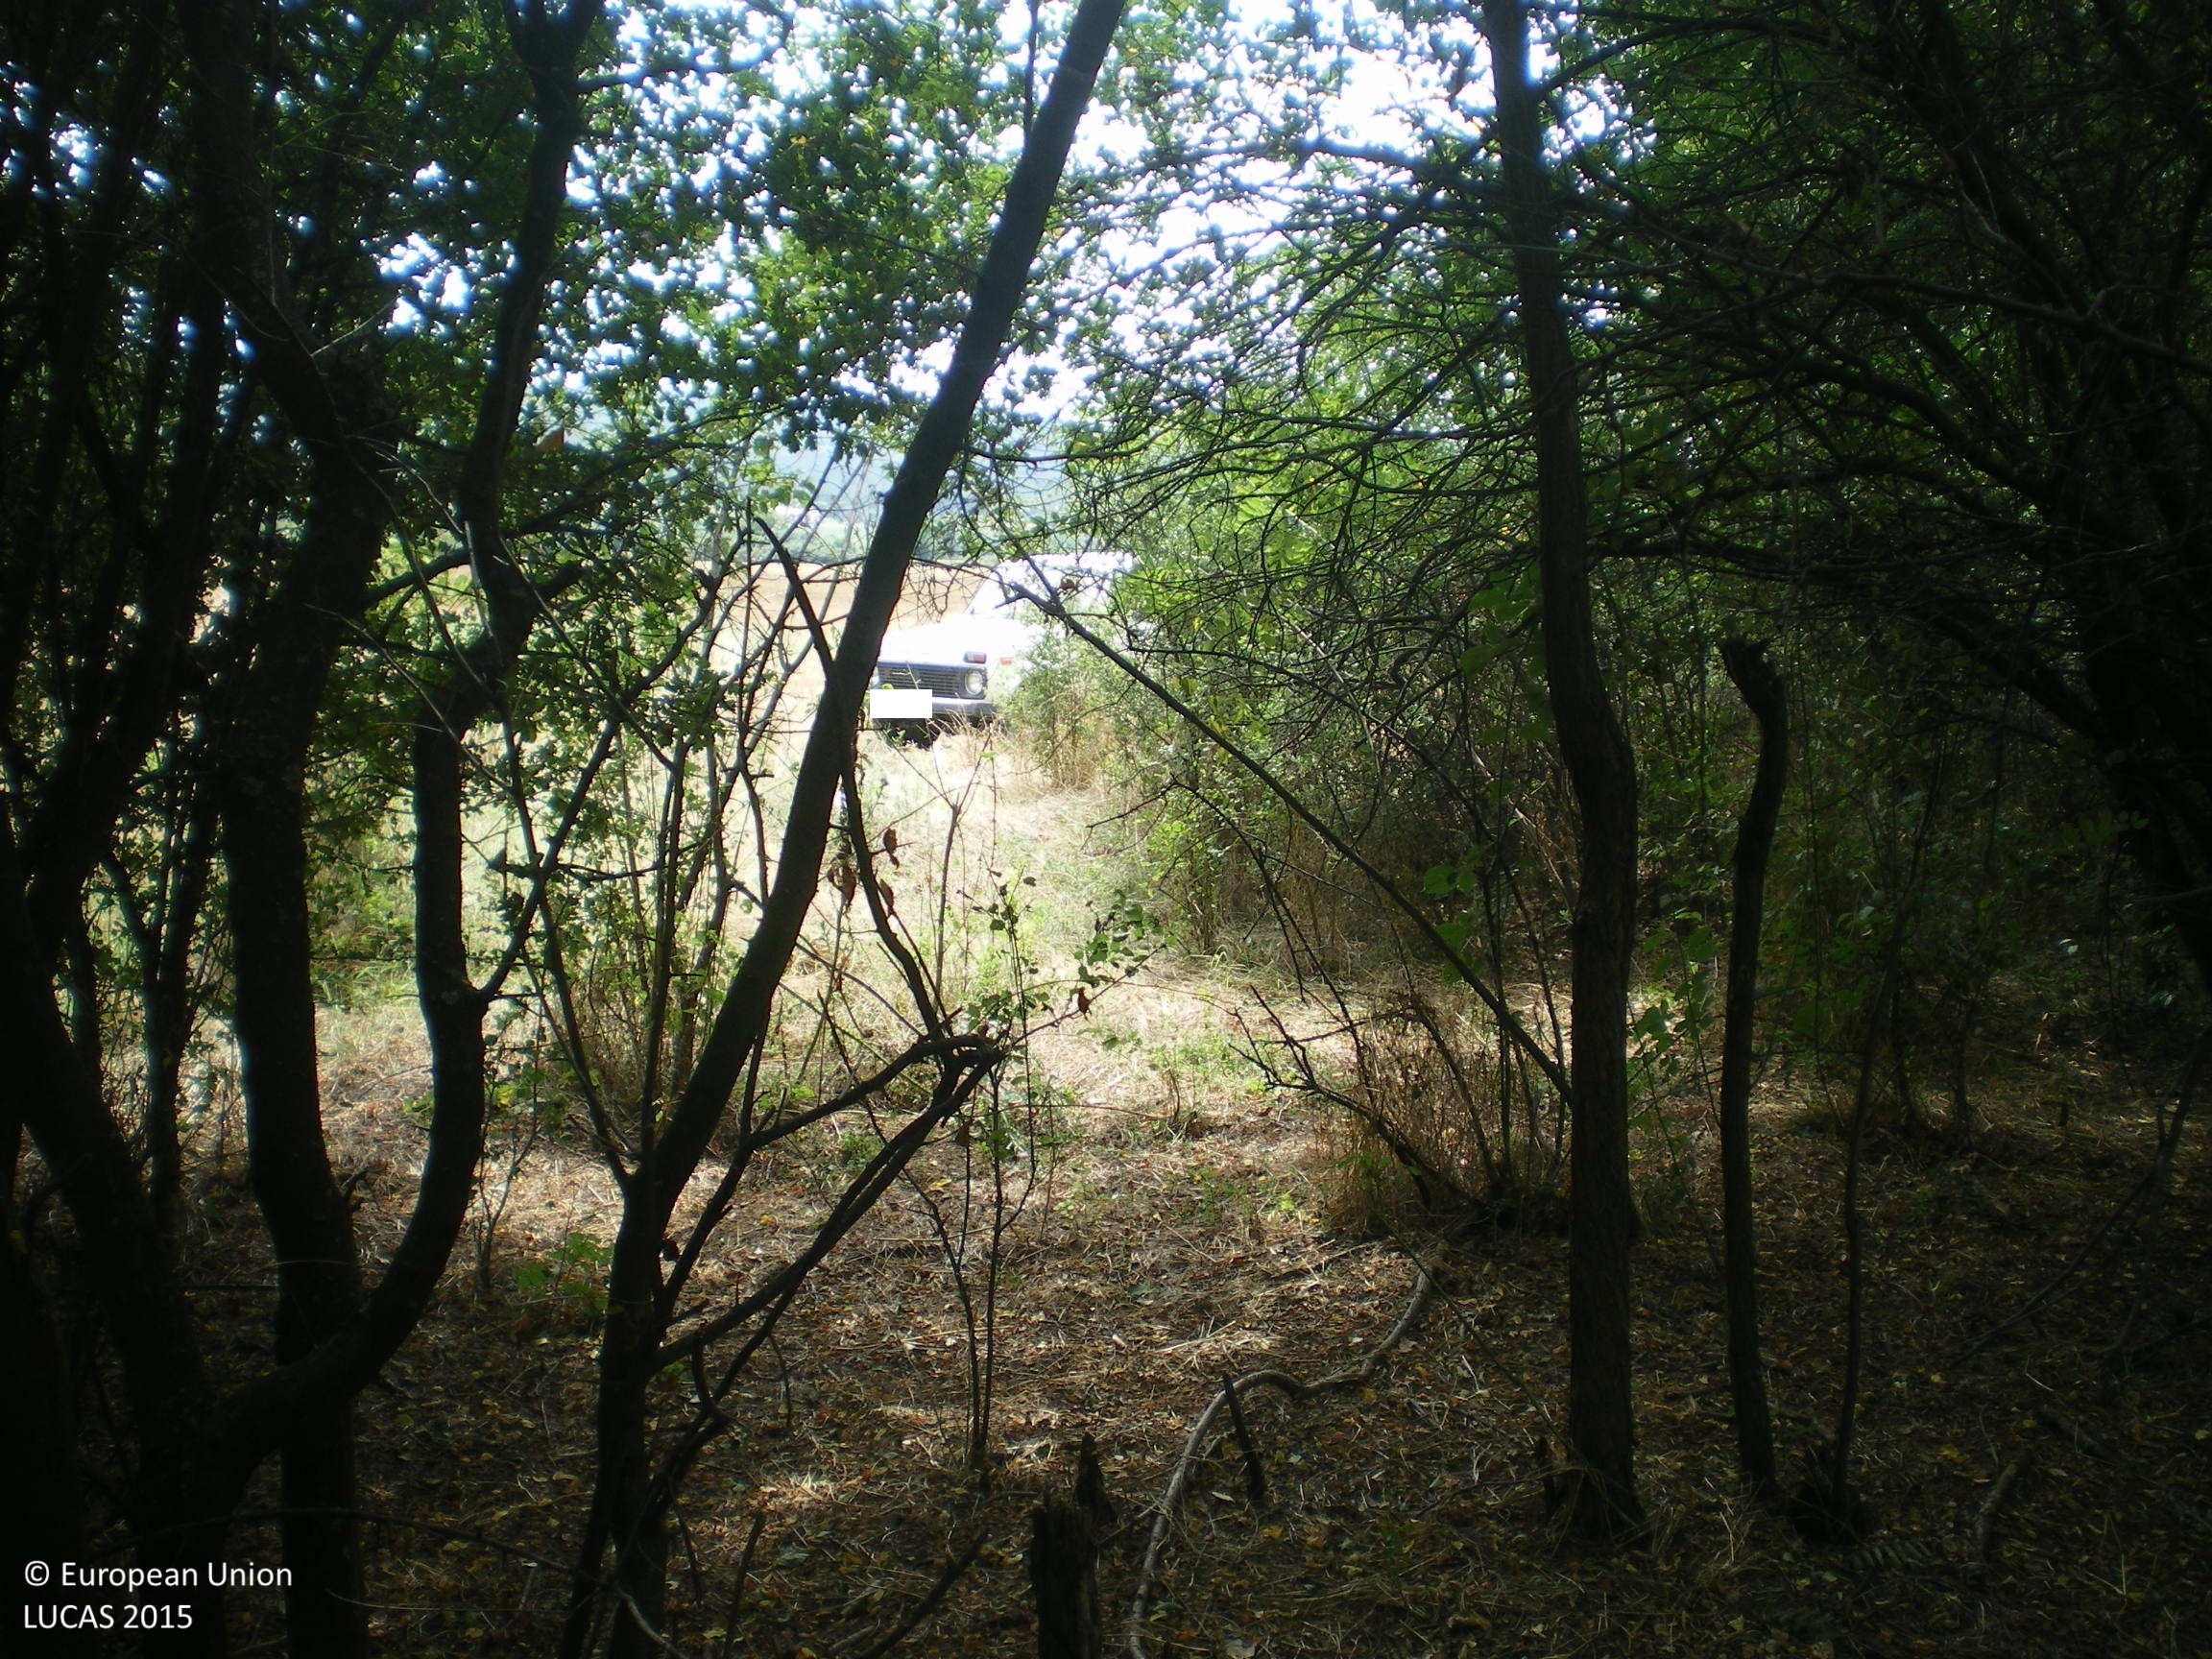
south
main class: Woodland
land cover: Broadleaved woodland
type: mesophytic deciduous forest
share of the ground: > 75 %
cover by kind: broadleaved forest trees 90 %, shrubs 5 %, herbaceous plants 5 %
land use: Forestry
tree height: > 5 m
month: August
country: BG
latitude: 42.5562
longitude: 25.6017
